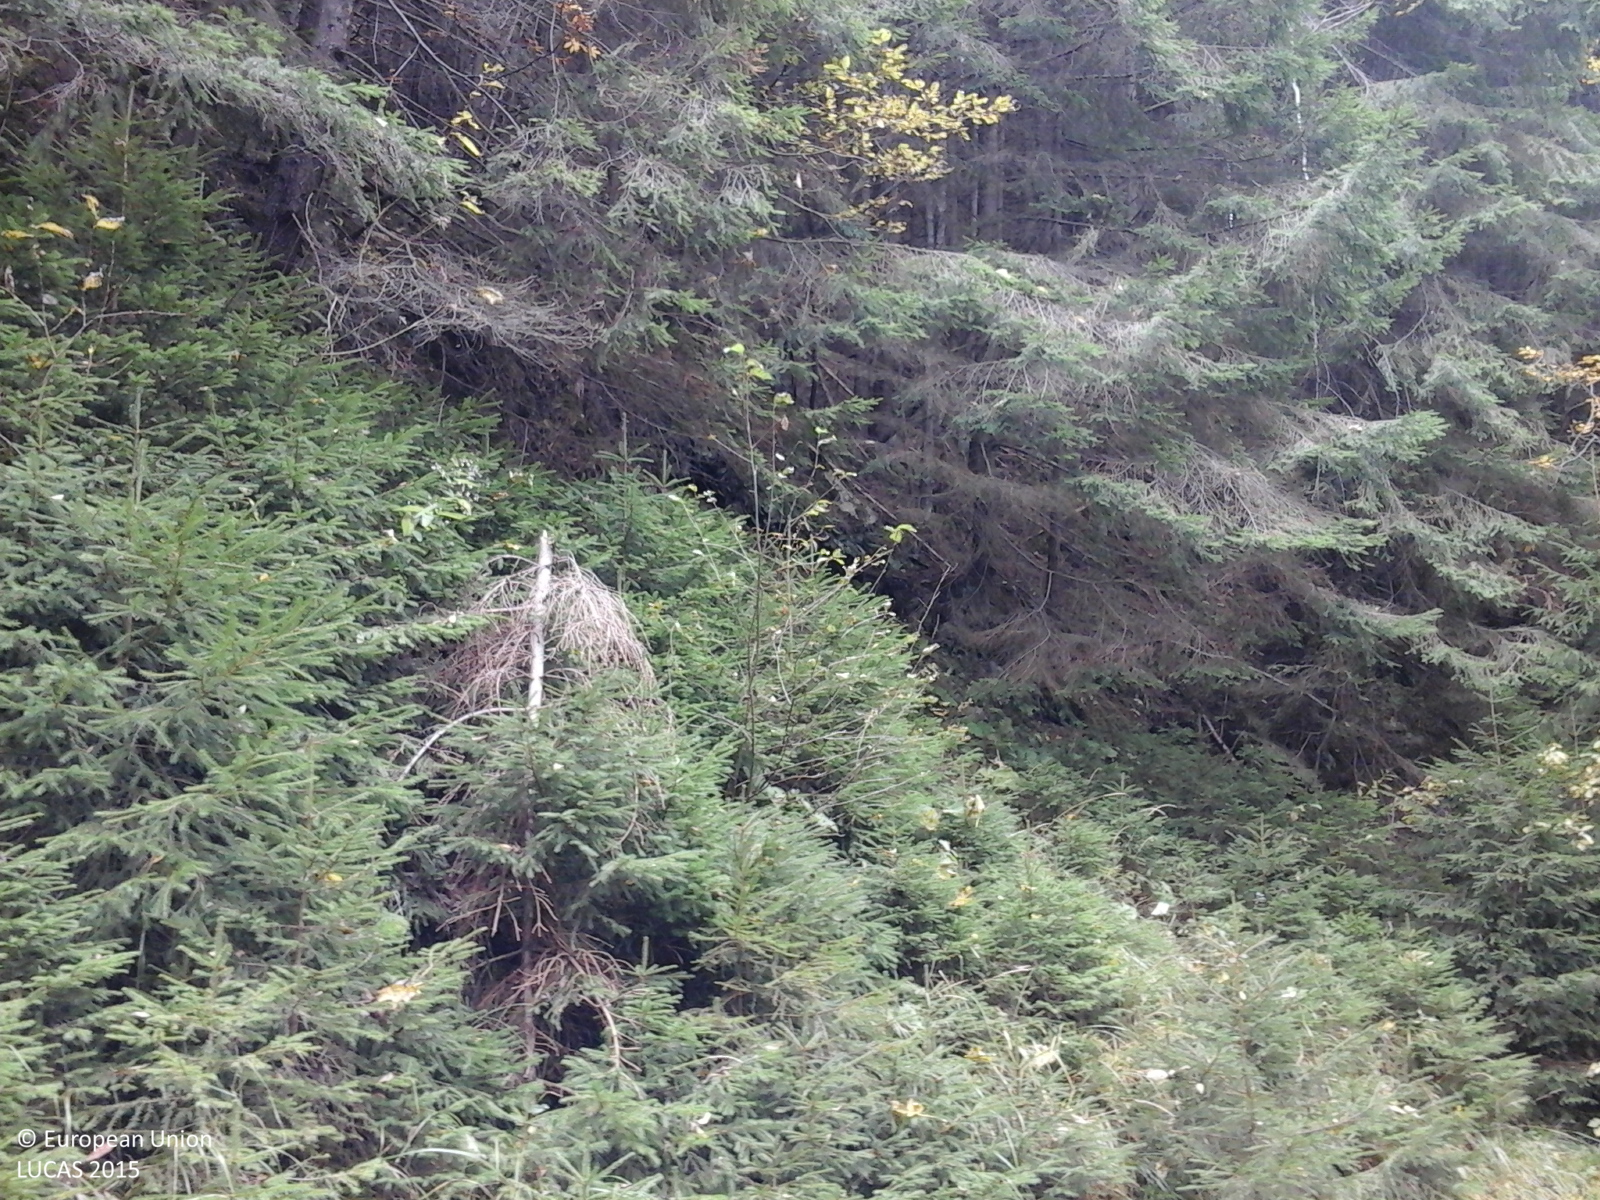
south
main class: Woodland
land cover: Spruce dominated mixed woodland
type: alpine coniferous forest
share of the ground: > 75 %
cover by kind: coniferous forest trees 75 %, broadleaved forest trees 25 %
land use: Forestry
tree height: > 5 m
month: October
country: RO
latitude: 45.5688
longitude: 25.0706
